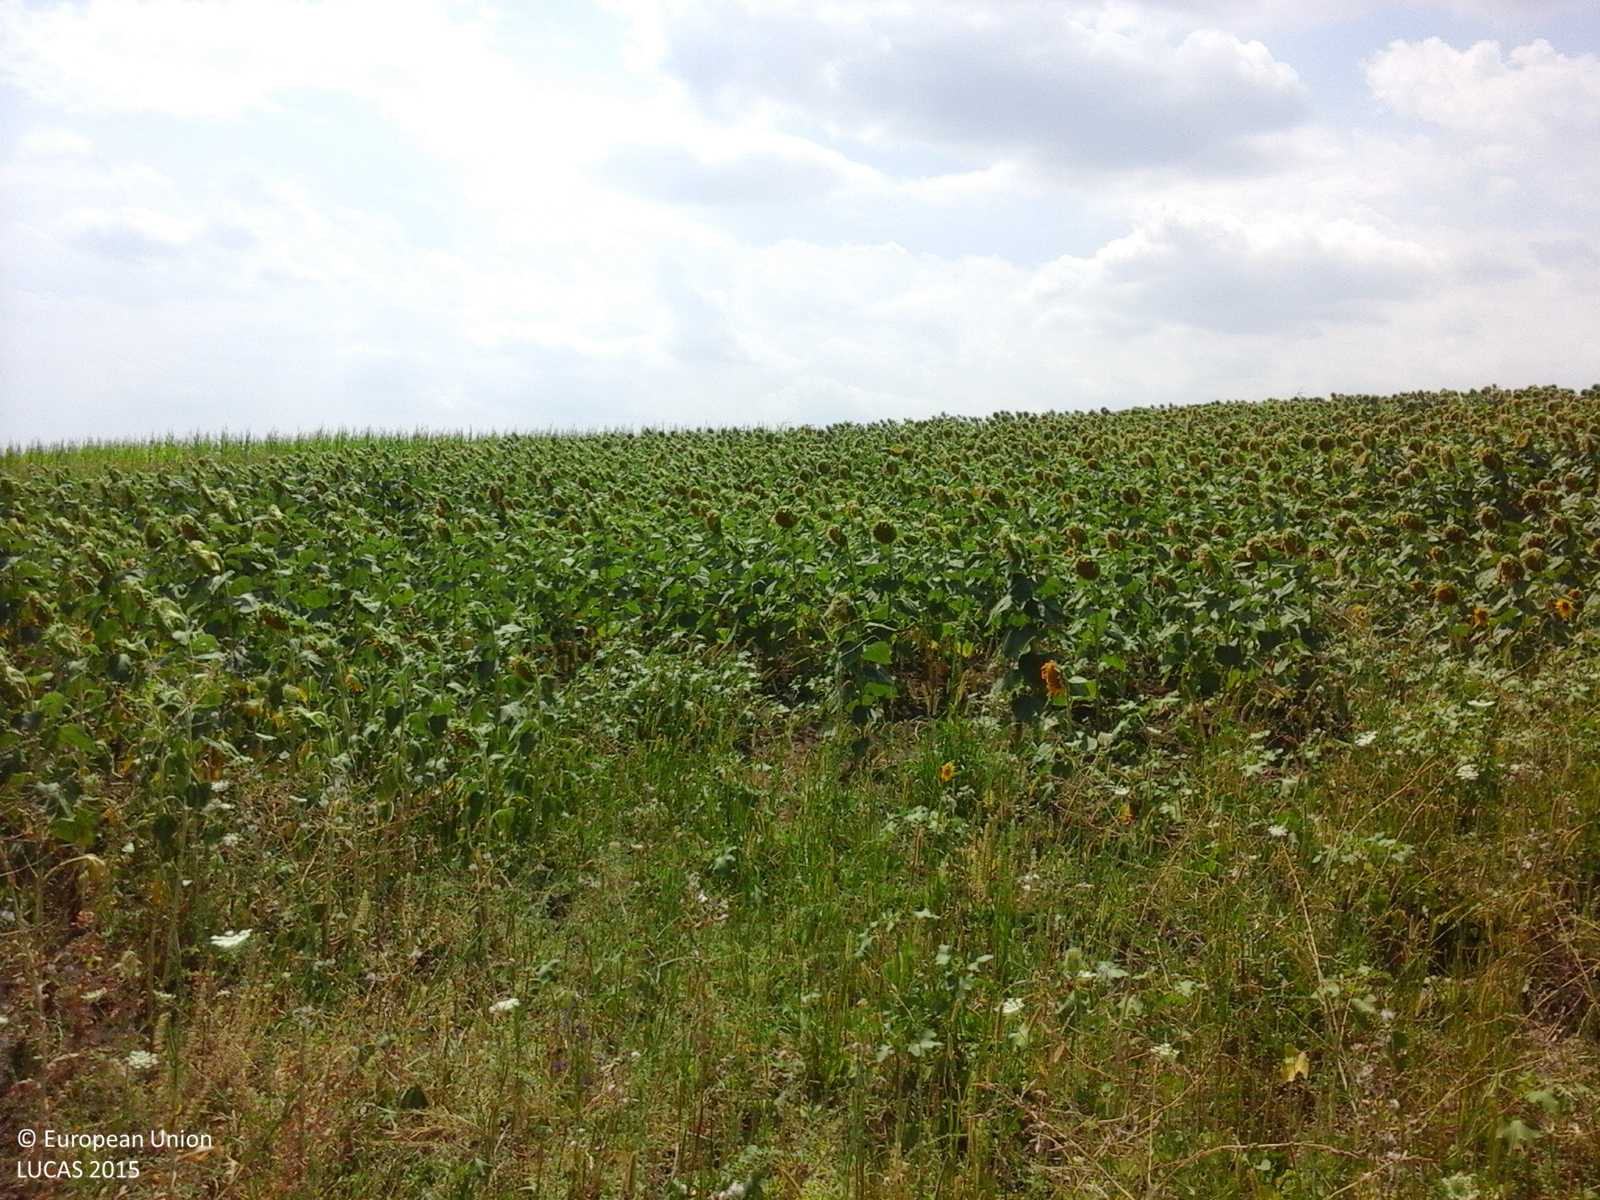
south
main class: Cropland
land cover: Sunflower
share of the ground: > 75 %
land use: Agriculture (excluding fallow land and kitchen gardens)
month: July
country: RO
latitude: 46.0745
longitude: 28.0316
